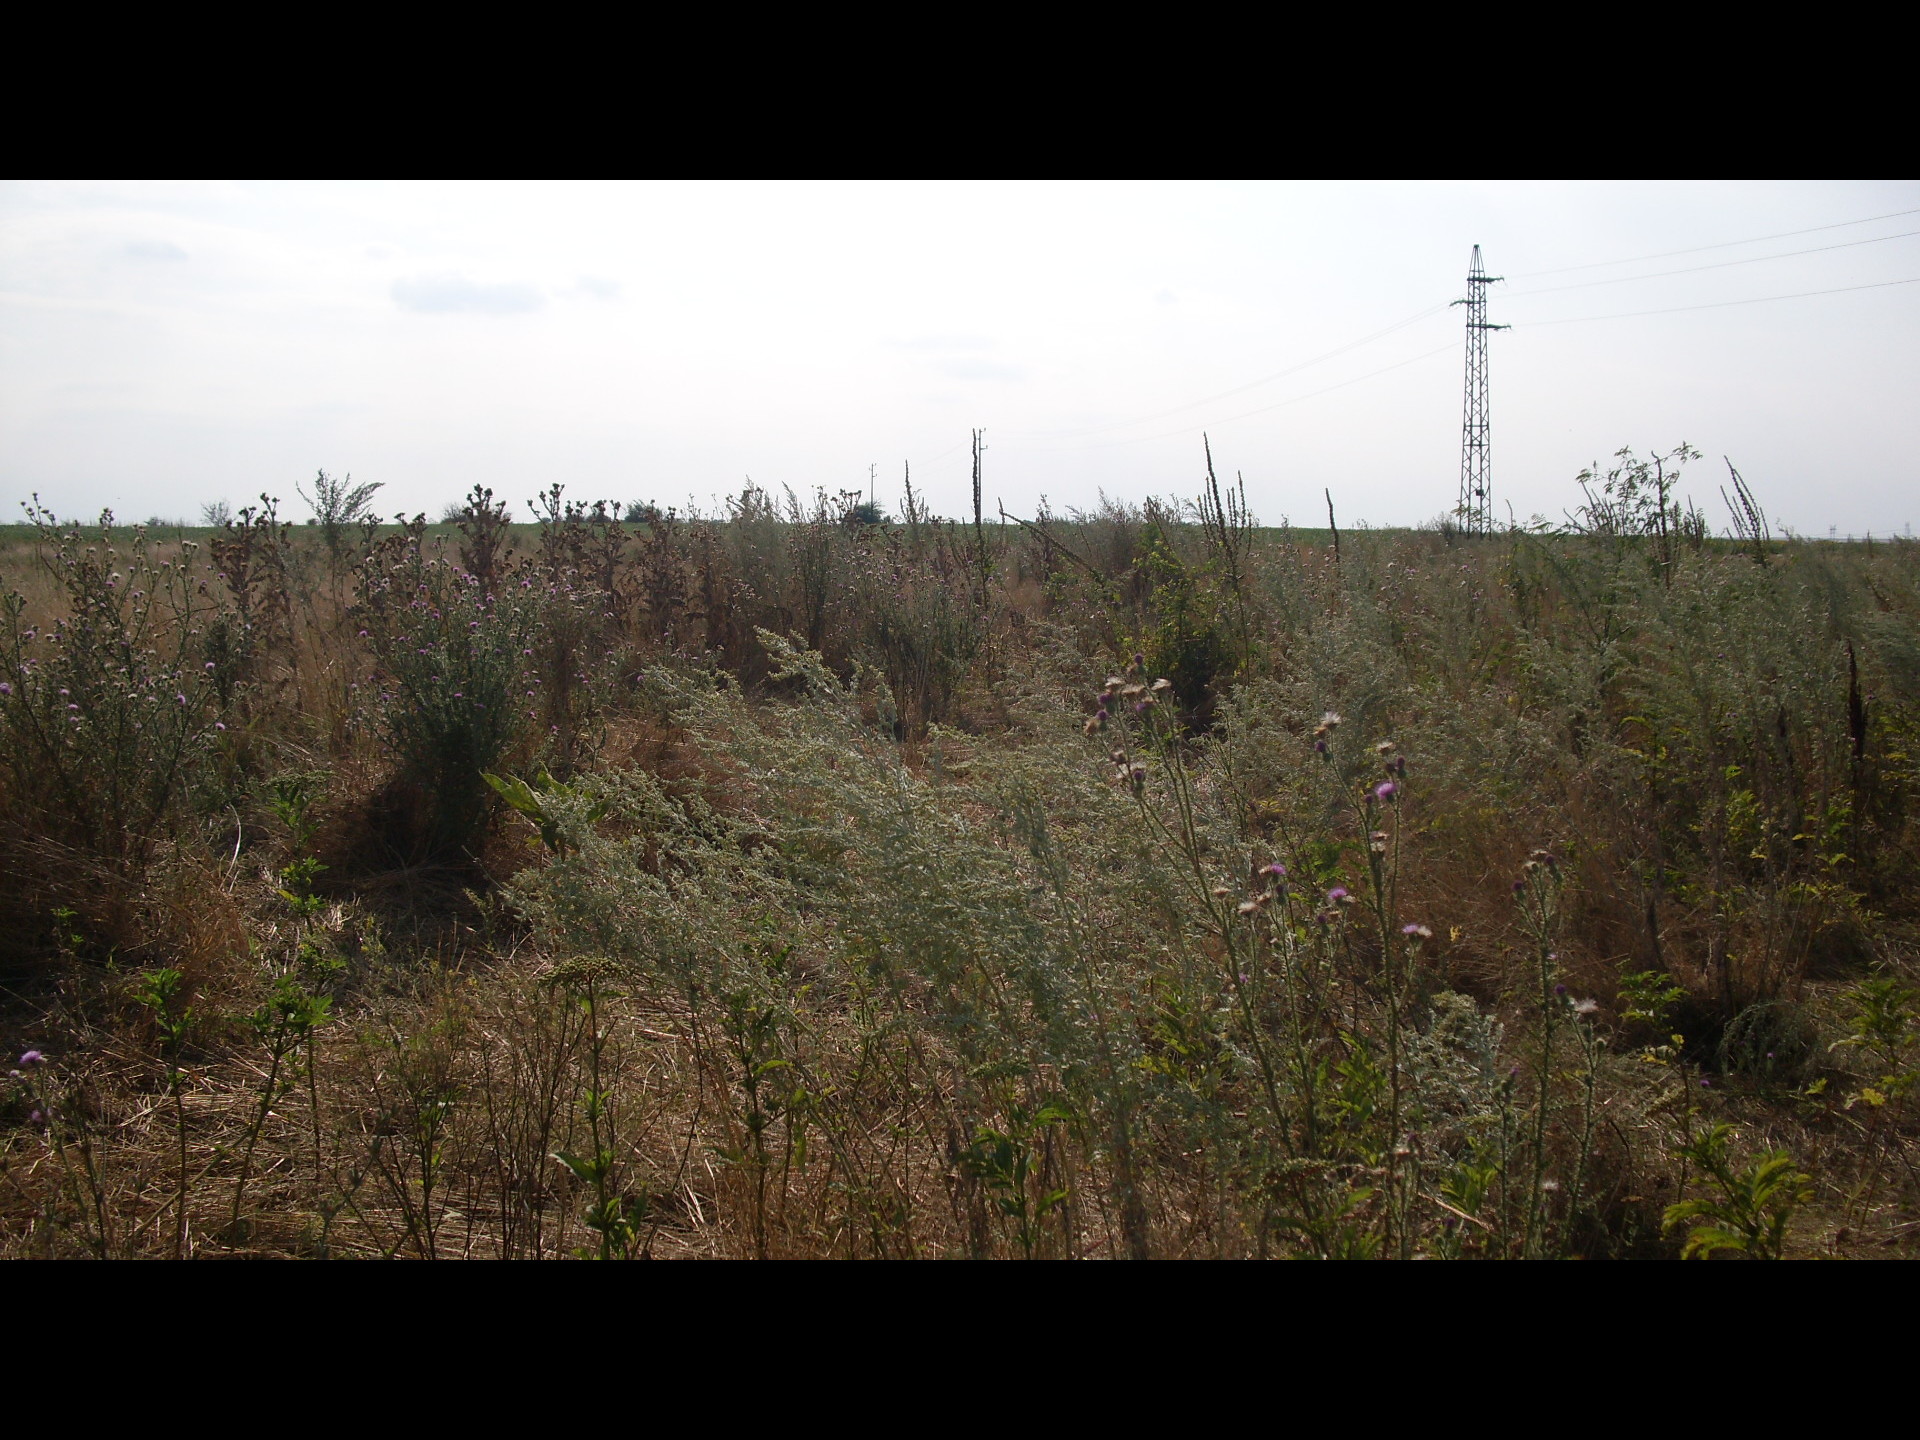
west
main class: Grassland
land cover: Grassland with sparse tree/shrub cover
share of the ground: > 75 %
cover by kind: herbaceous plants 85 %, shrubs 10 %, broadleaved forest trees 5 %
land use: Agriculture (excluding fallow land and kitchen gardens)
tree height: < 5 m
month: August
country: BG
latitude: 43.6672
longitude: 23.7542
